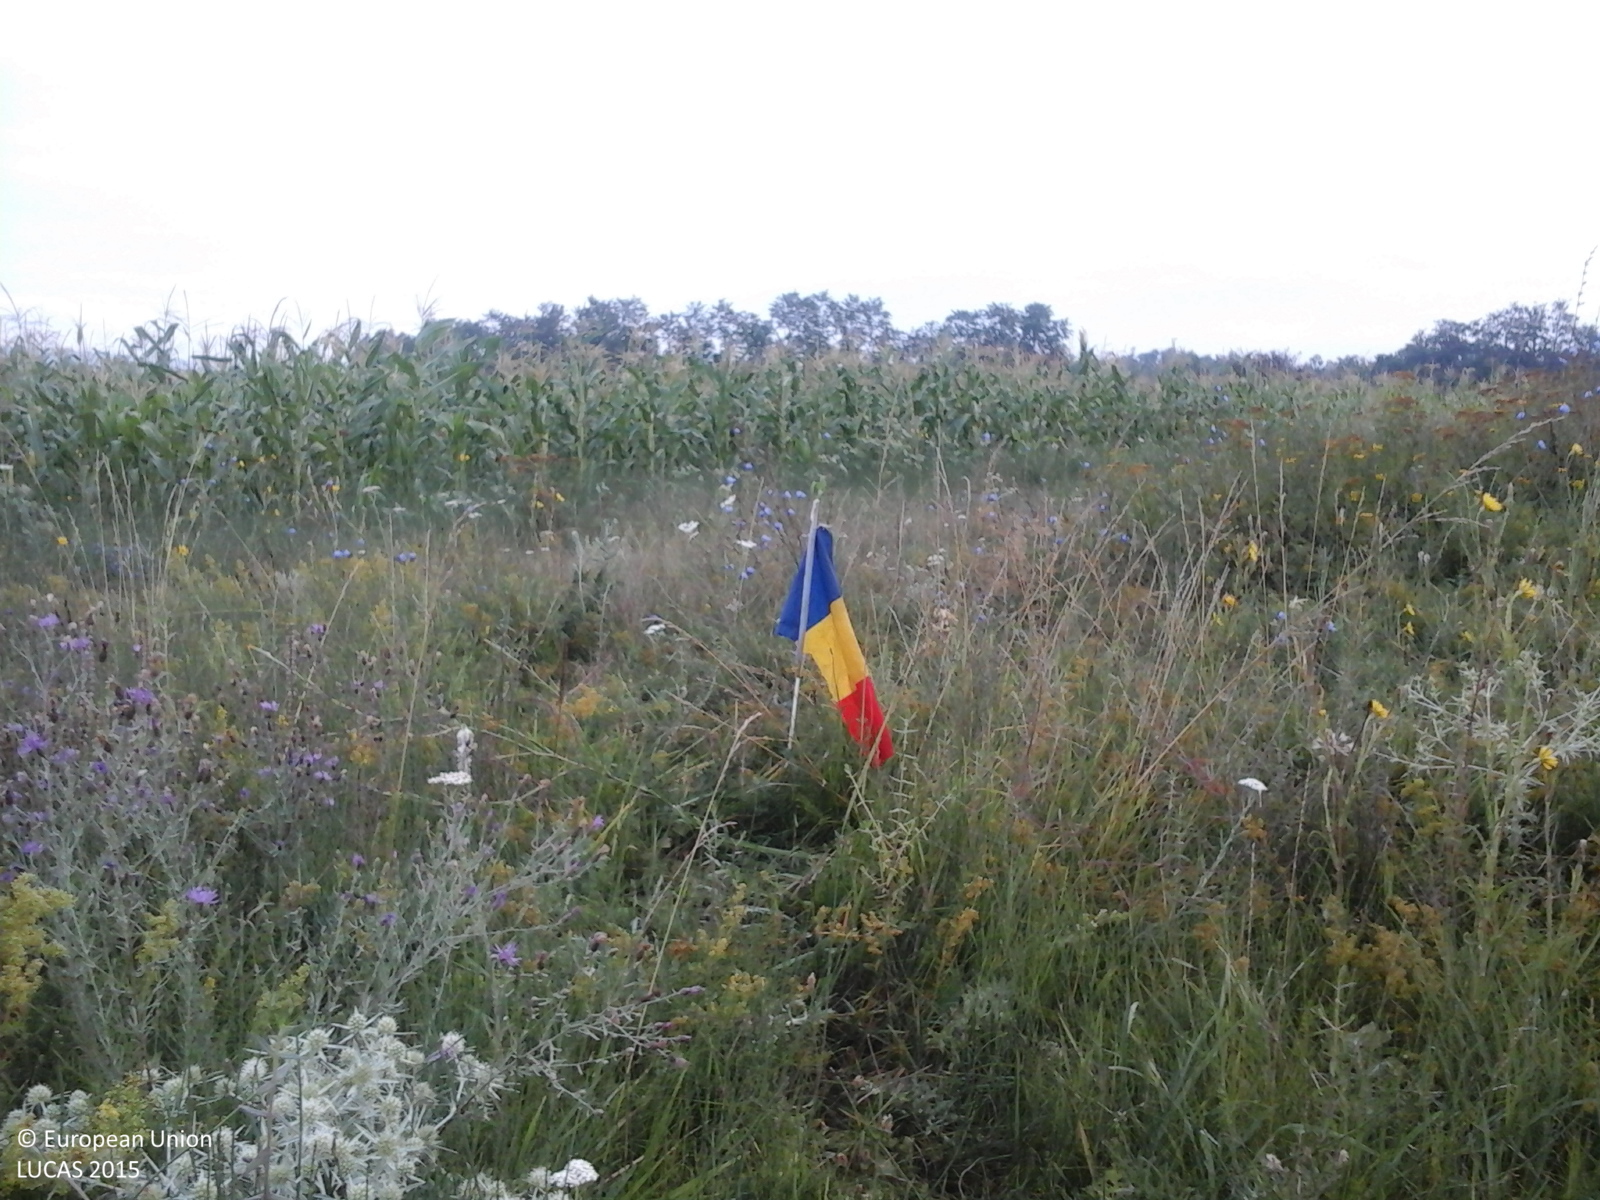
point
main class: Grassland
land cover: Spontaneously vegetated surfaces
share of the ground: > 75 %
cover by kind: herbaceous plants 100 %
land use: Fallow land
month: July
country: RO
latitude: 46.3527
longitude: 27.8055
